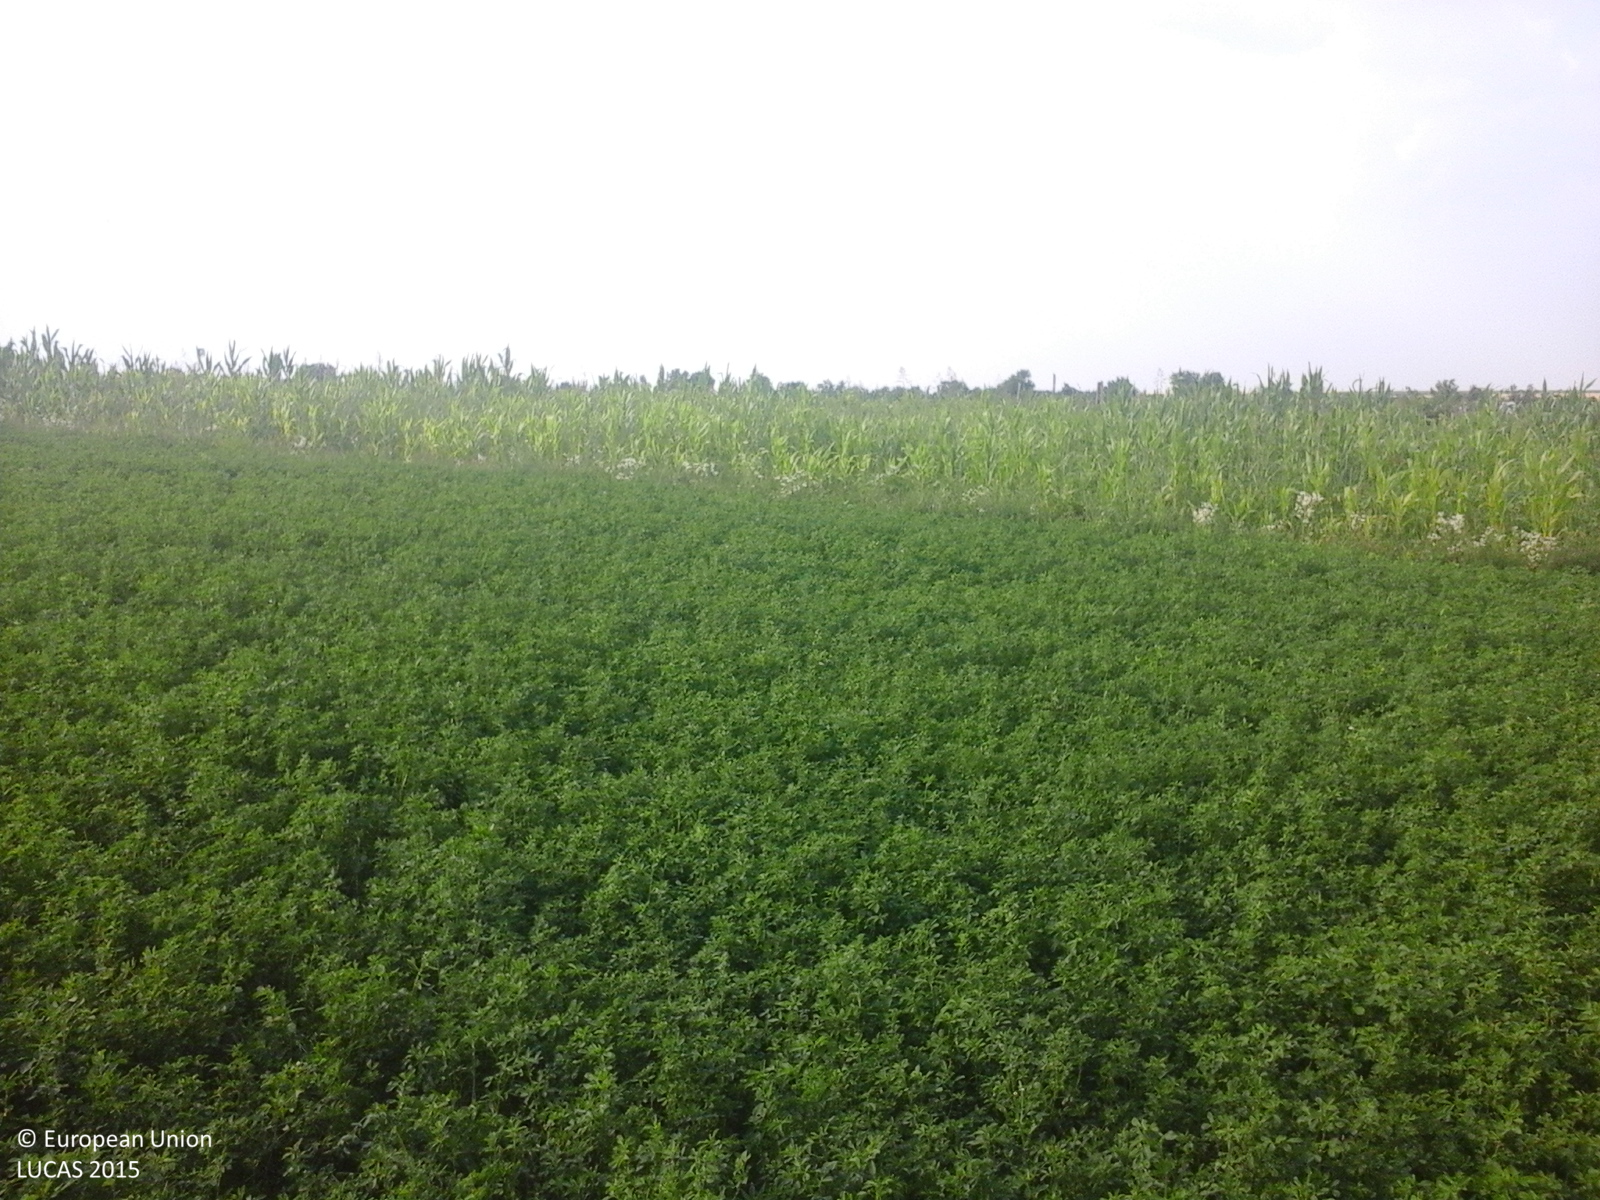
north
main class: Cropland
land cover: Lucerne
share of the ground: > 75 %
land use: Agriculture (excluding fallow land and kitchen gardens)
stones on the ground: < 10 %
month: July
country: RO
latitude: 43.8555
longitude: 24.7626
